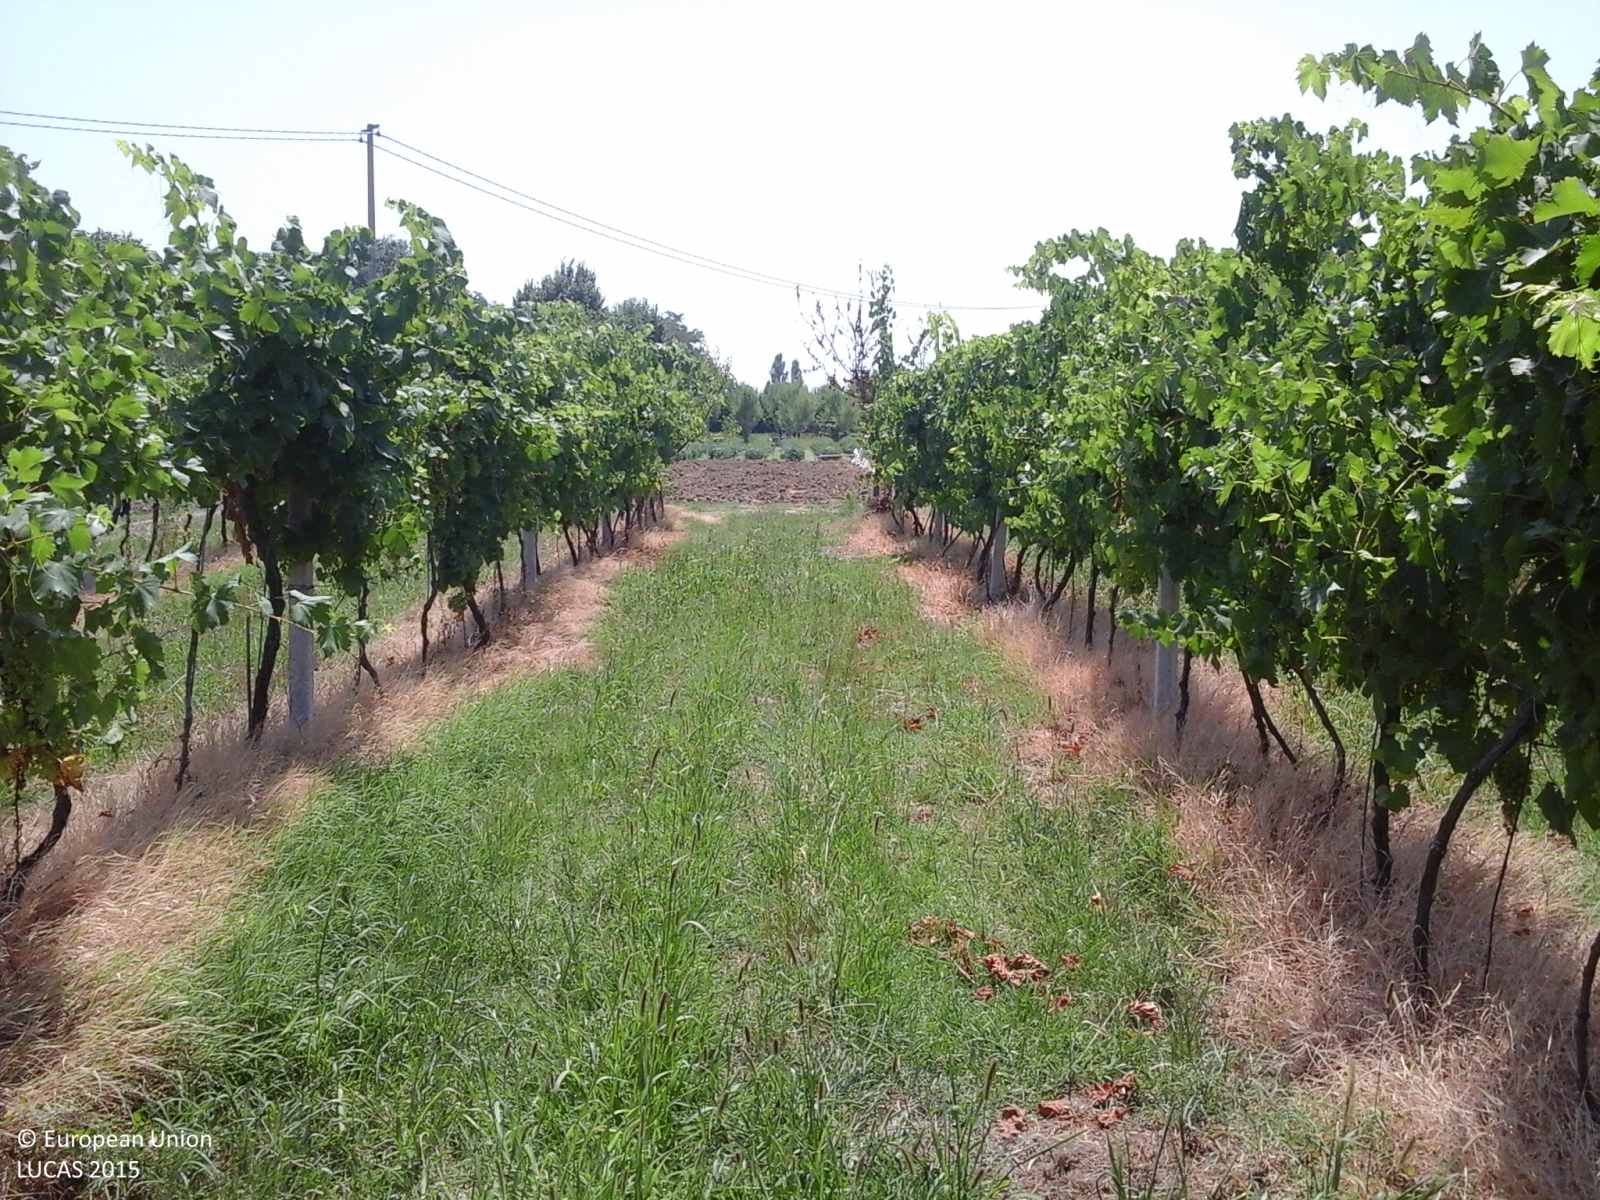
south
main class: Cropland
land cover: Vineyards
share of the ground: 50 - 75 %
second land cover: Grassland without tree/shrub cover
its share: > 75 %
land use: Agriculture (excluding fallow land and kitchen gardens)
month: July
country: IT
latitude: 44.1428
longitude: 12.3823
